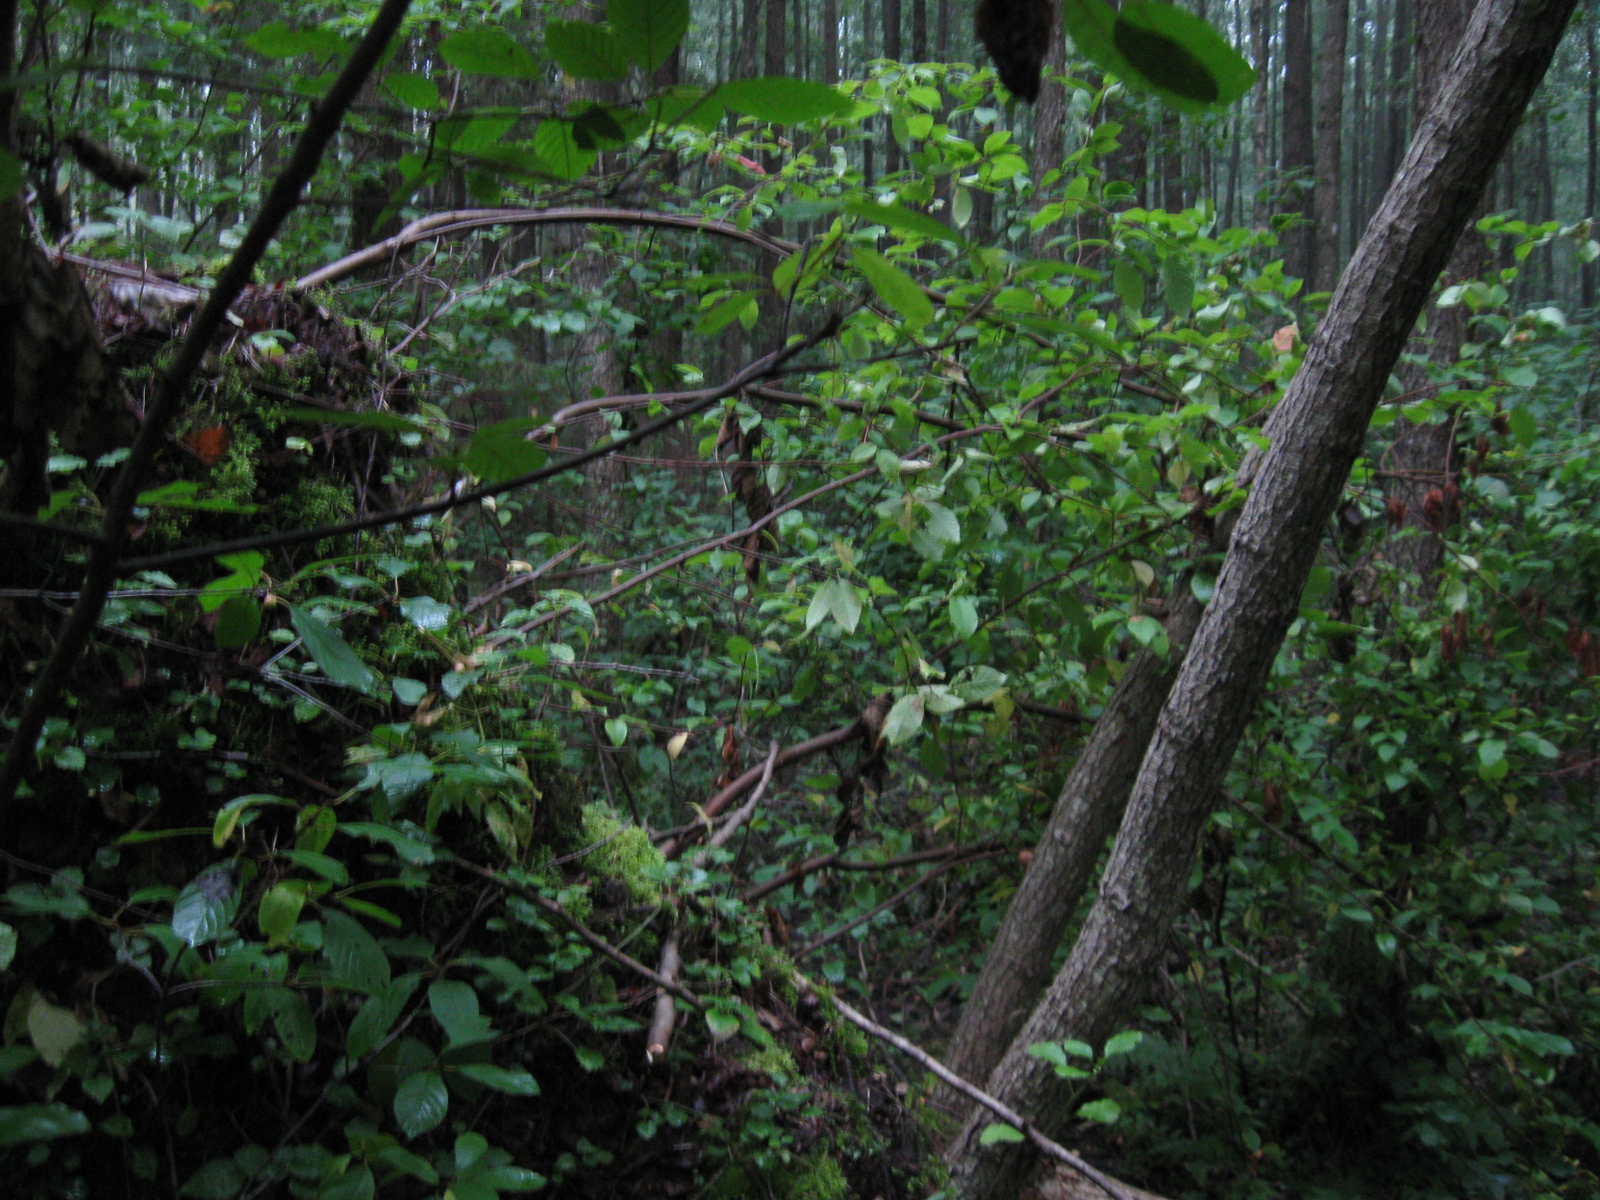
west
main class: Woodland
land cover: Broadleaved woodland
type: non-riverine alder, birch or aspen forest
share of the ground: > 75 %
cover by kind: broadleaved forest trees 85 %, coniferous forest trees 5 %, shrubs 5 %, herbaceous plants 5 %
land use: Forestry
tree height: > 5 m
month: August
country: LT
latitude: 54.7454
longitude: 23.6143
